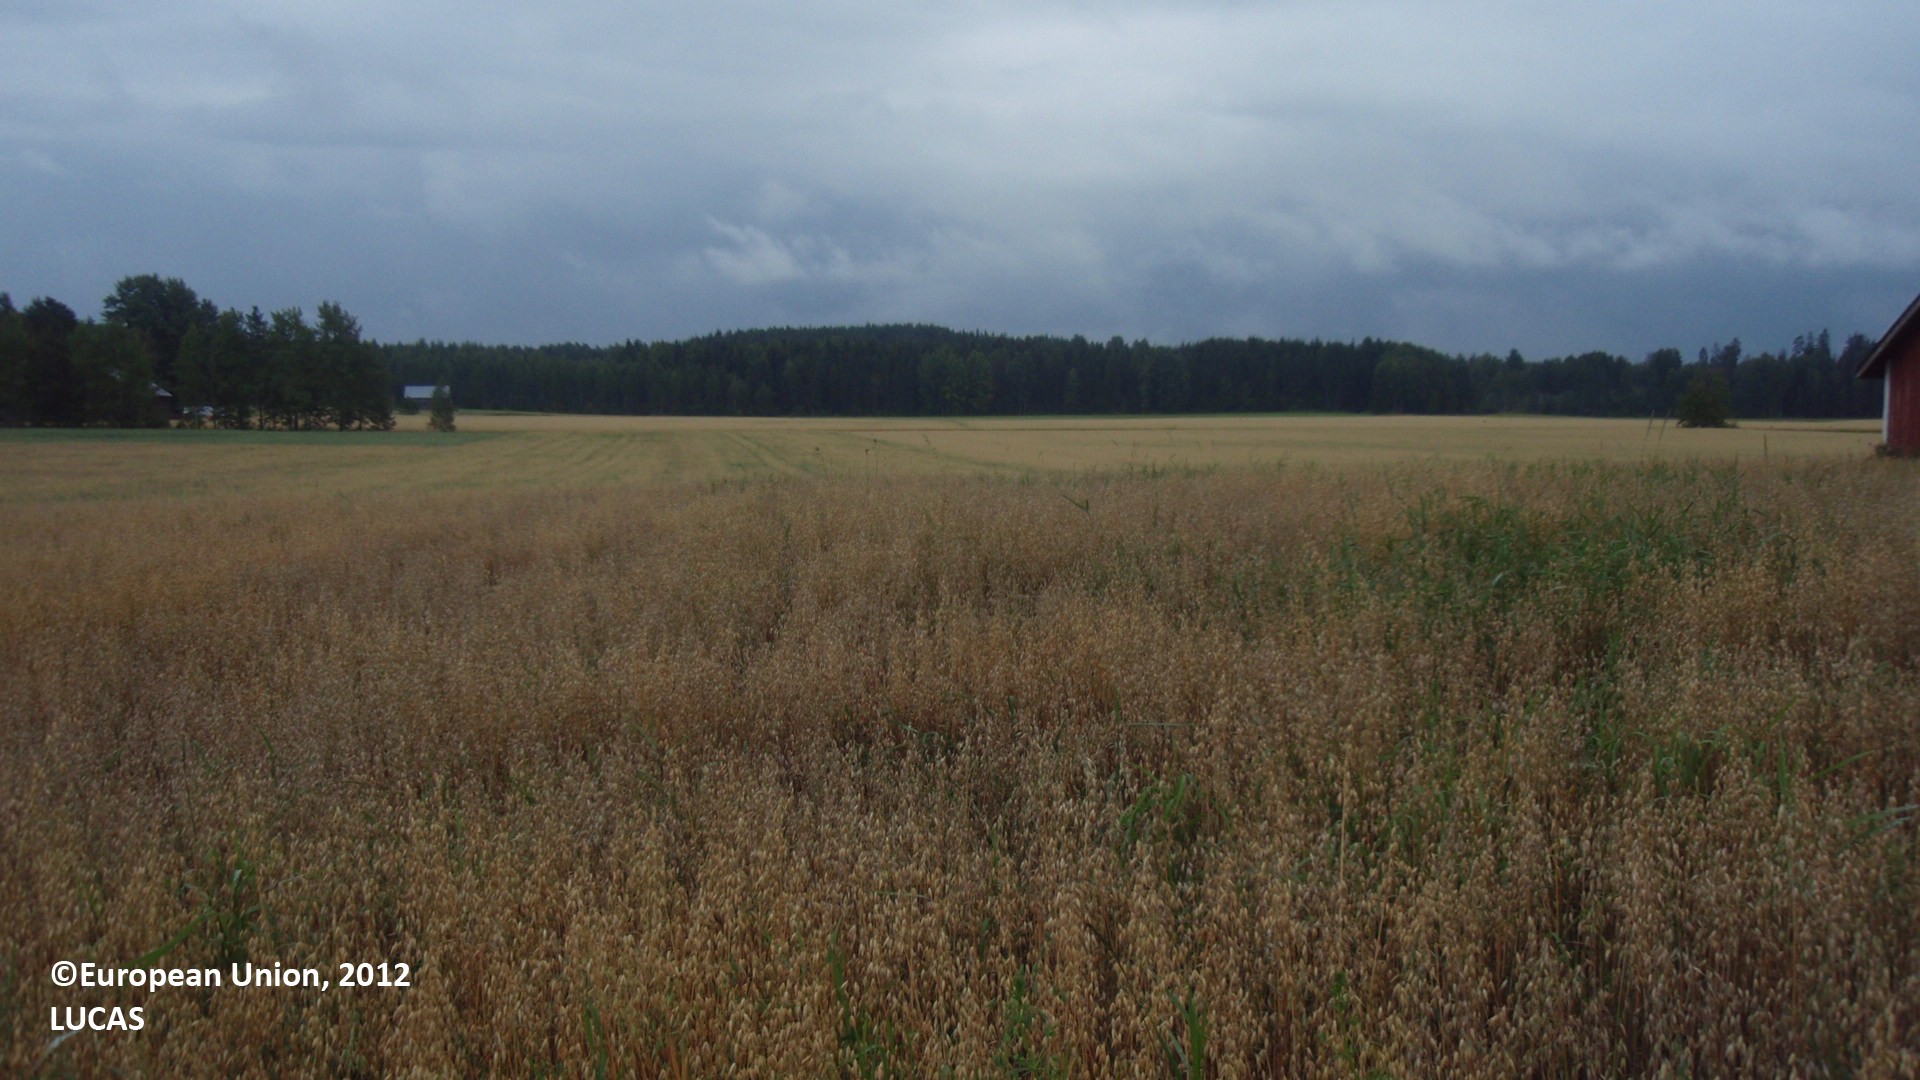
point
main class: Cropland
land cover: Oats
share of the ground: > 75 %
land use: Agriculture (excluding fallow land and kitchen gardens)
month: August
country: FI
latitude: 60.7375
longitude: 26.9103
